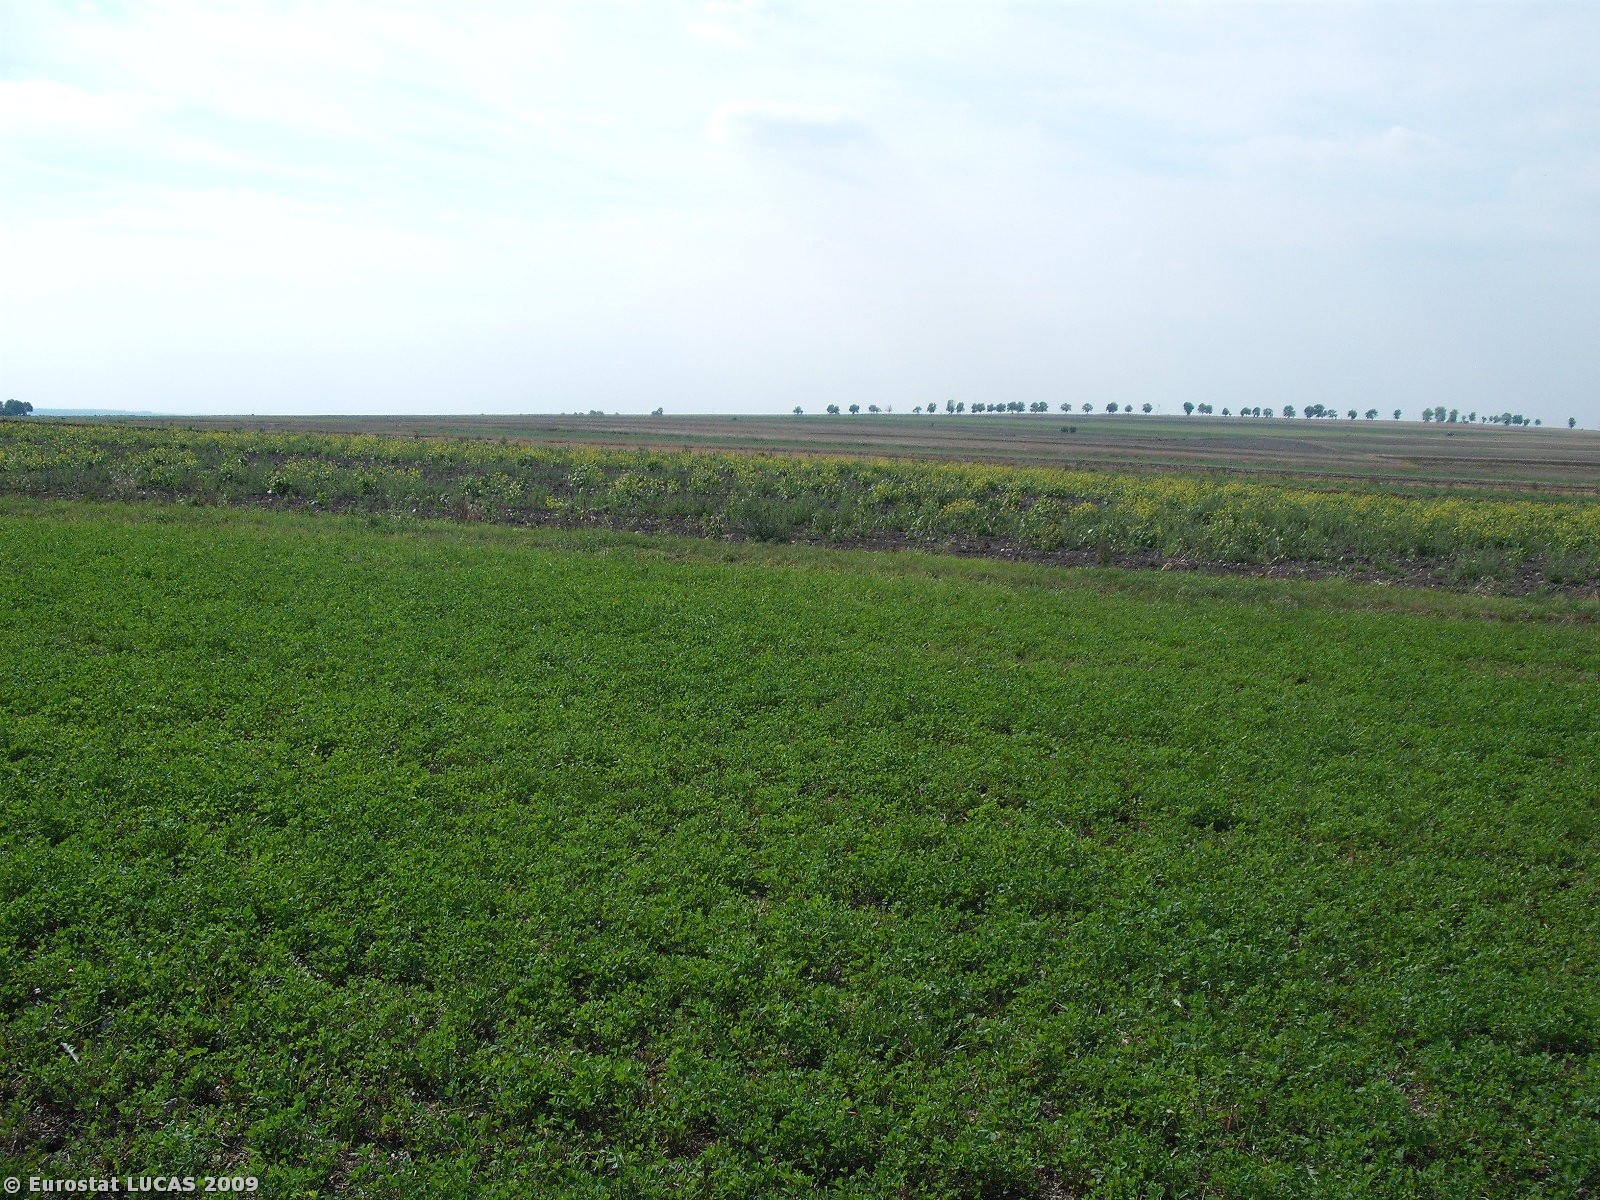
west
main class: Cropland
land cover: Lucerne
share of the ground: > 75 %
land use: Agriculture (excluding fallow land and kitchen gardens)
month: September
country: PL
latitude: 50.5457
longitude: 20.3522
